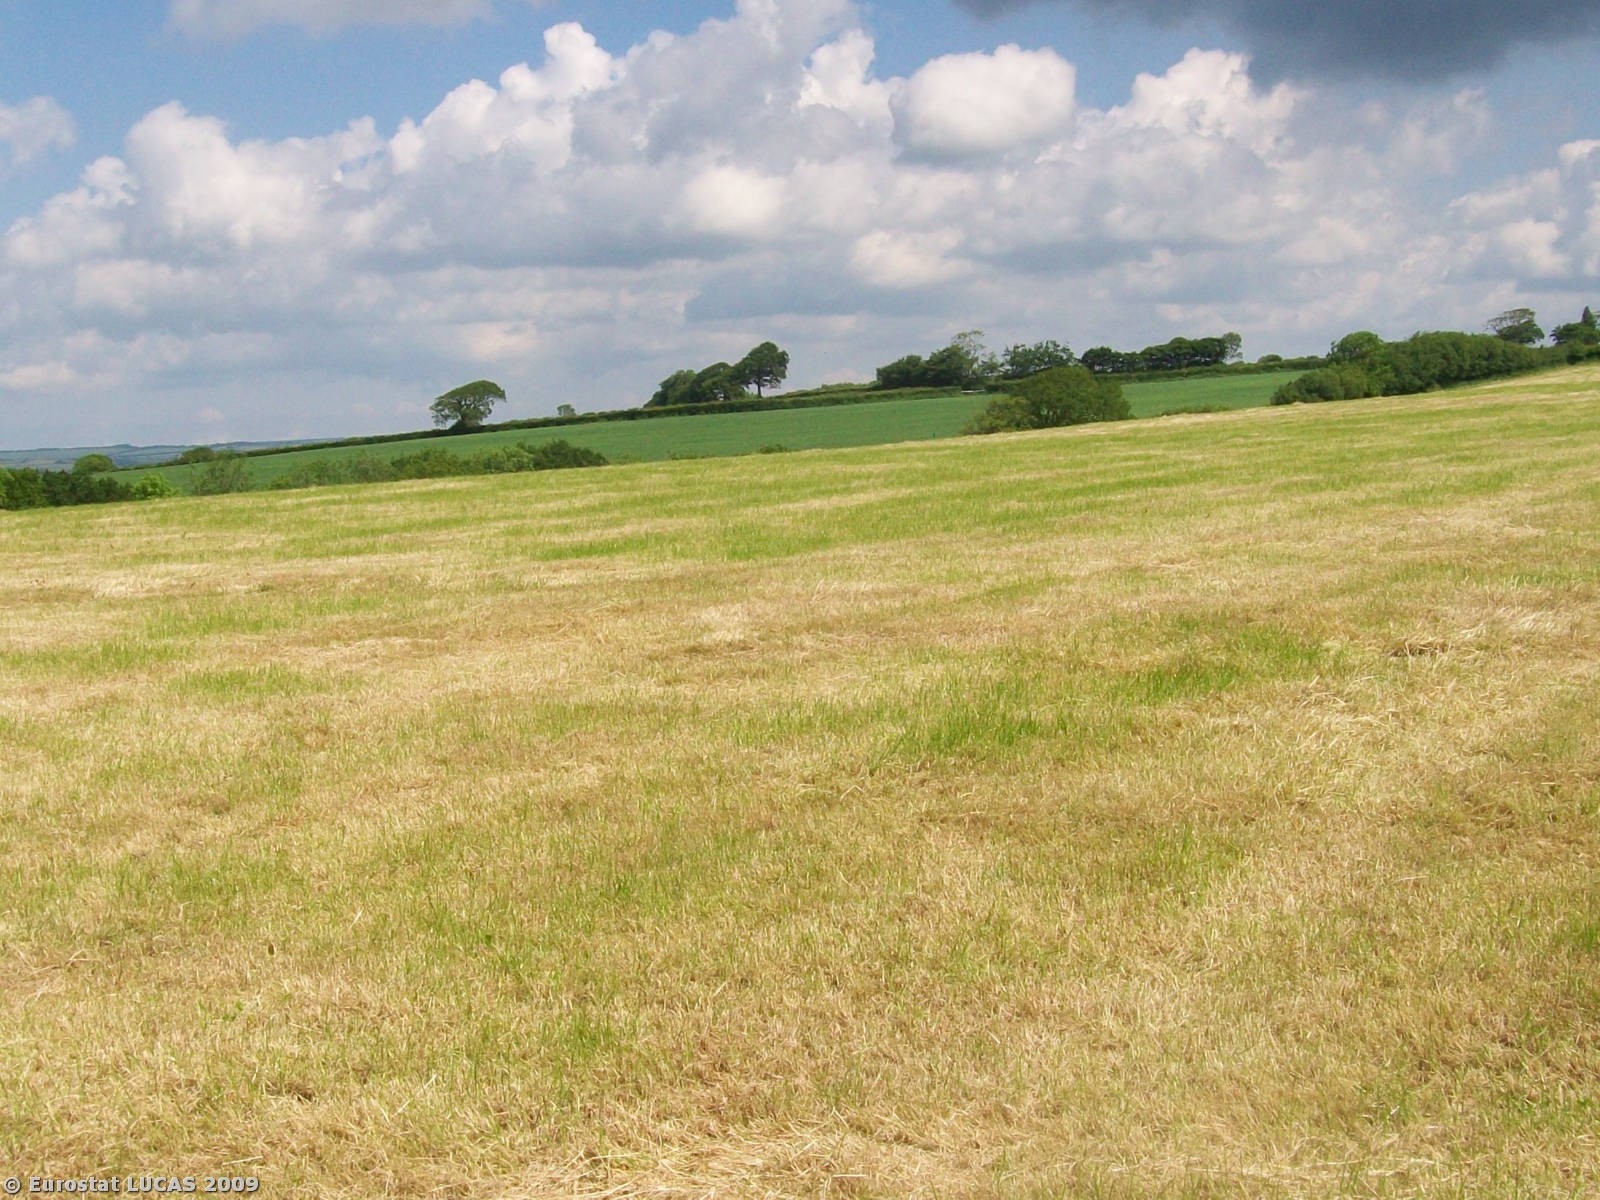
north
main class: Grassland
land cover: Grassland without tree/shrub cover
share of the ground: > 75 %
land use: Agriculture (excluding fallow land and kitchen gardens)
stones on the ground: < 10 %
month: June
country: GB
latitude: 50.9575
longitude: -3.3934
